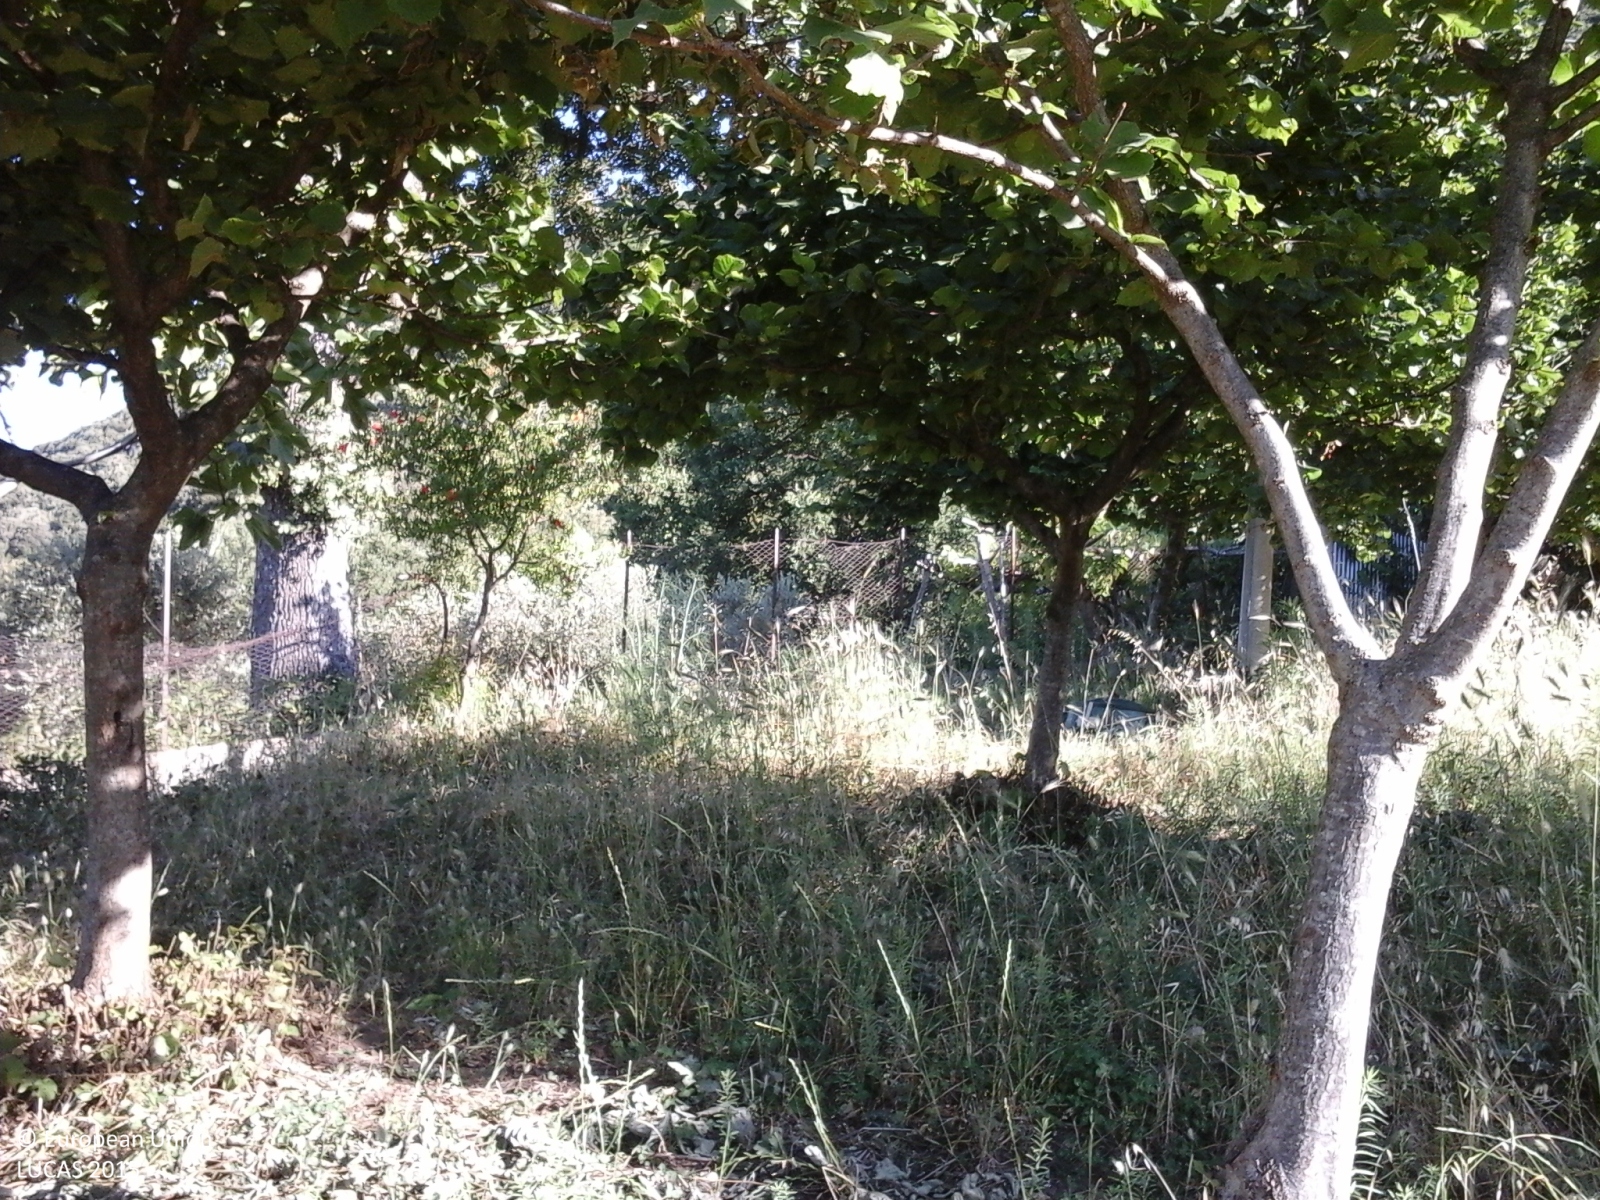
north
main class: Woodland
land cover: Broadleaved woodland
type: thermophilous deciduous forest
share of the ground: > 75 %
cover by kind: broadleaved forest trees 100 %
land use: Forestry
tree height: > 5 m
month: June
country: IT
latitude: 40.4245
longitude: 15.1053
